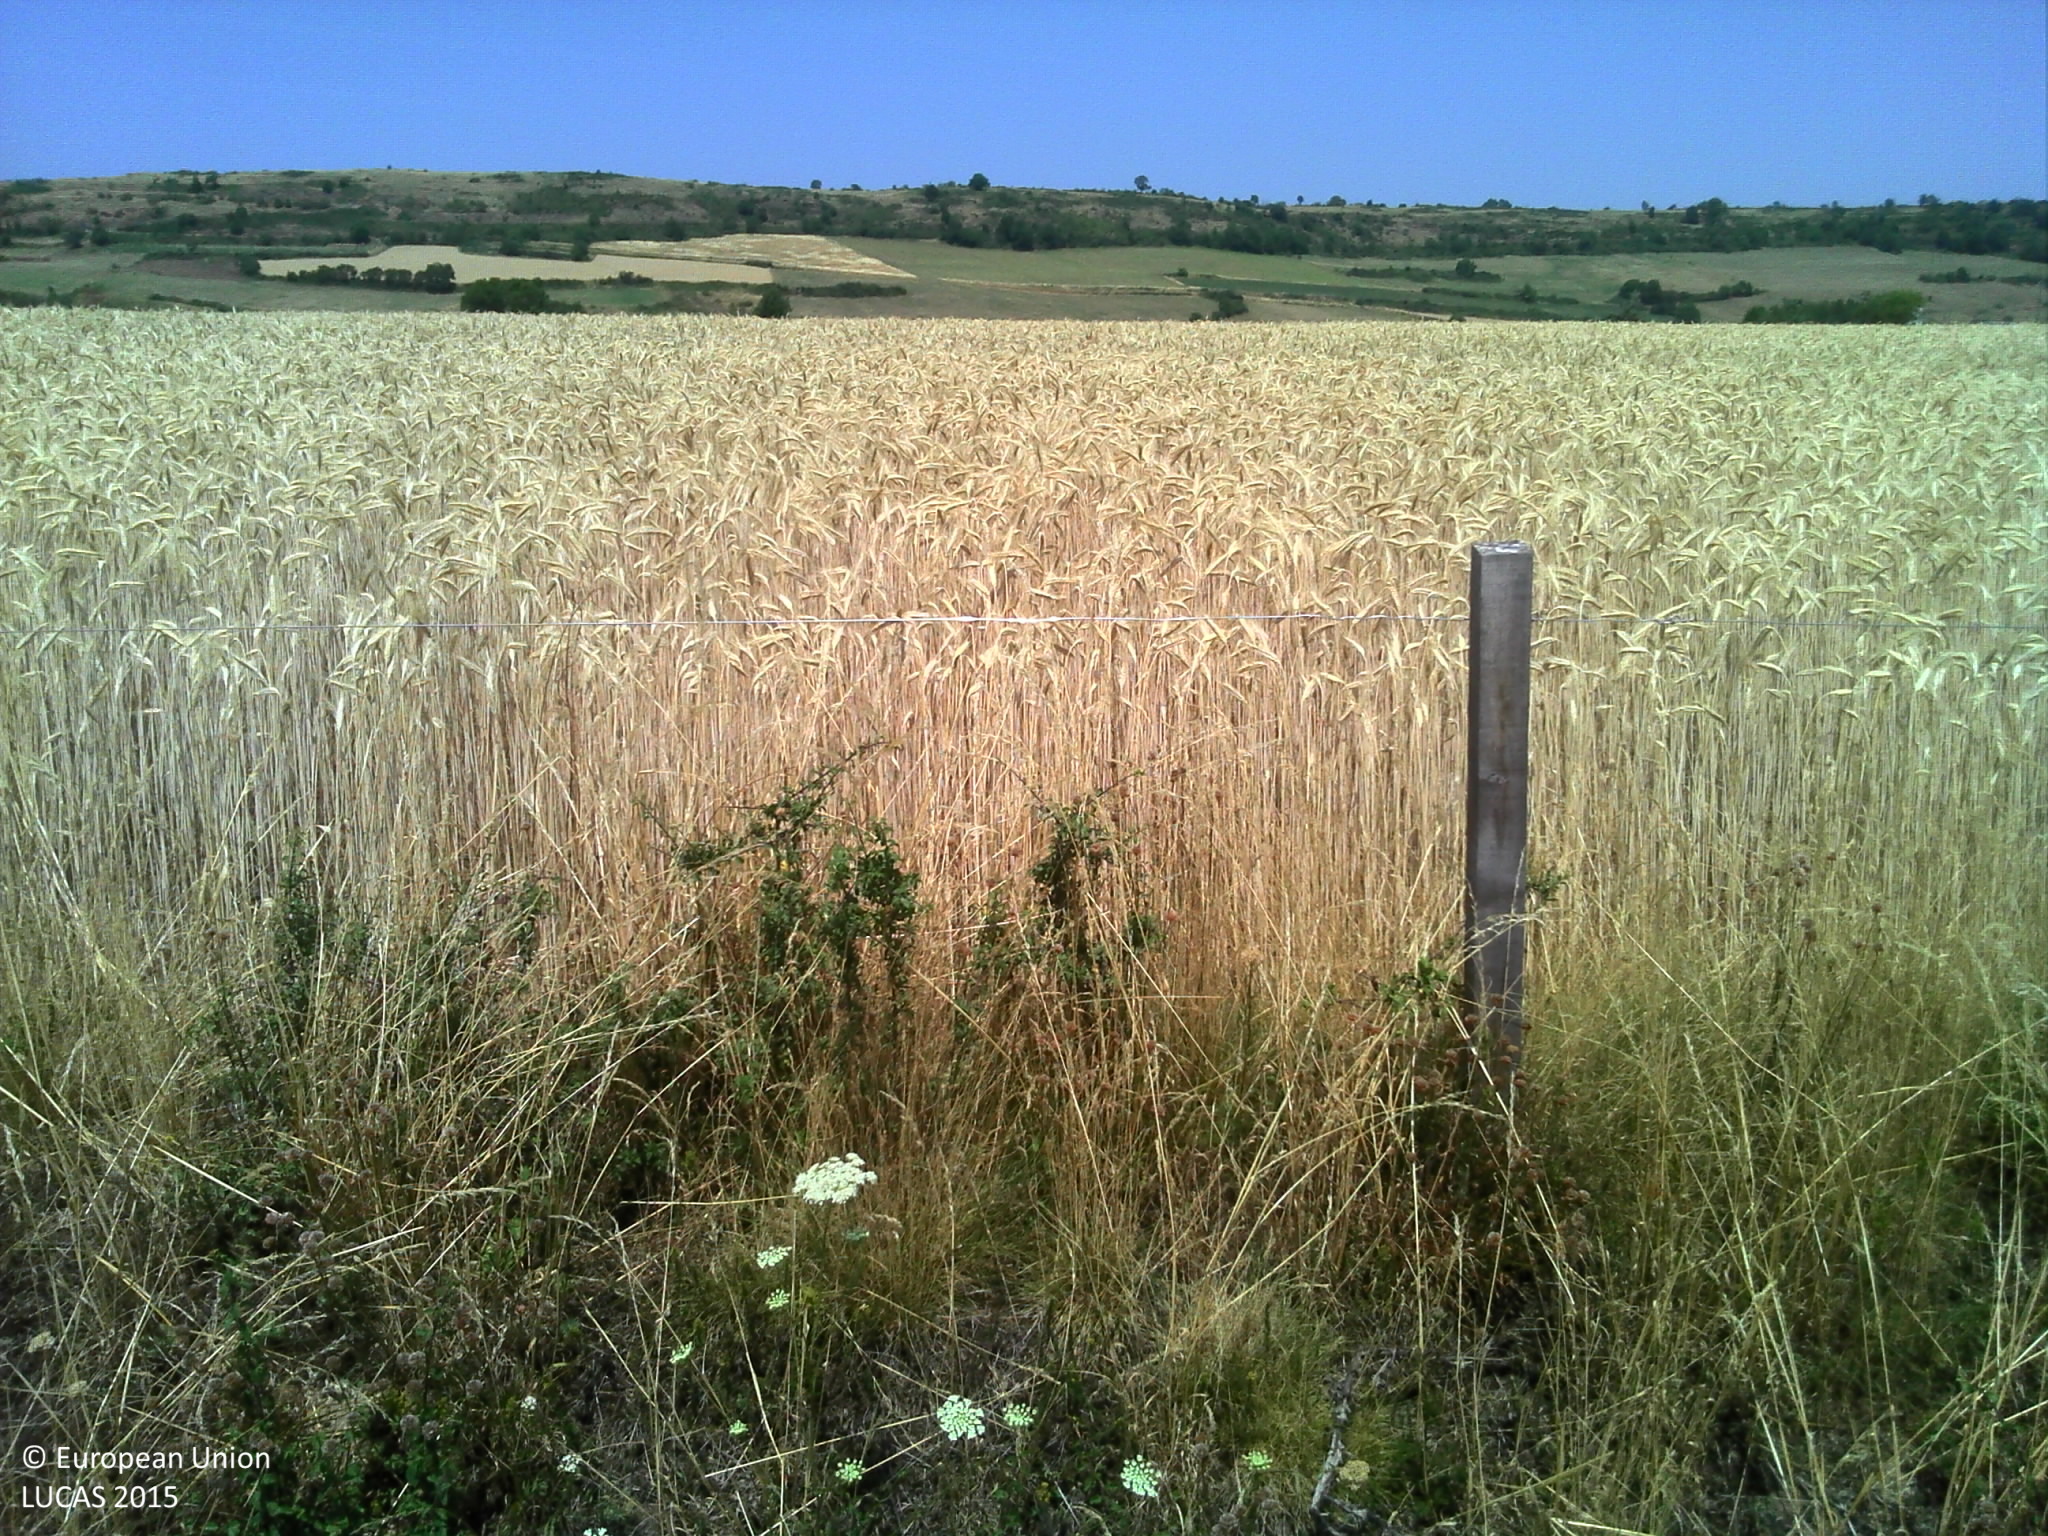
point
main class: Cropland
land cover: Rye
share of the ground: > 75 %
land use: Agriculture (excluding fallow land and kitchen gardens)
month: July
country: FR
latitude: 45.3360
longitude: 3.1489
